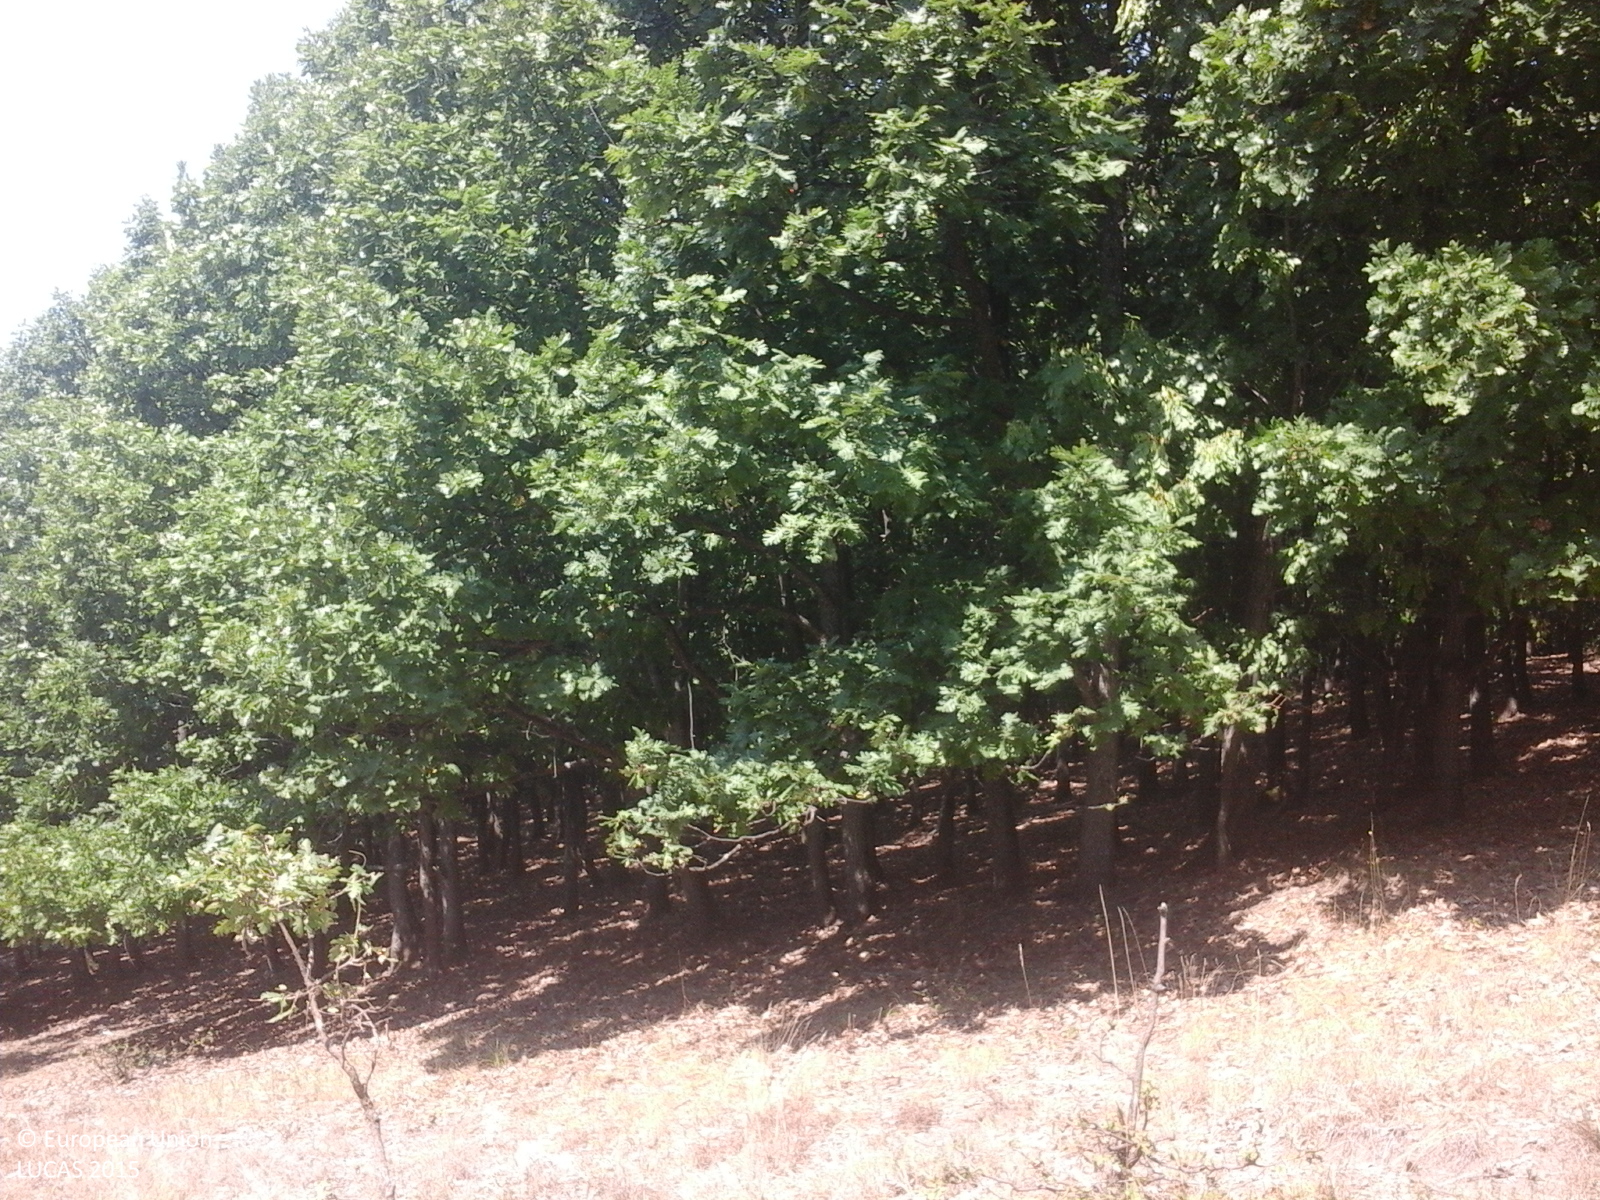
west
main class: Woodland
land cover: Broadleaved woodland
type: acidophilous oak and oak-birch forest
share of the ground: > 75 %
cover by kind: broadleaved forest trees 100 %
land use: Forestry
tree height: > 5 m
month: August
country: RO
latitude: 44.5207
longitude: 23.6566
